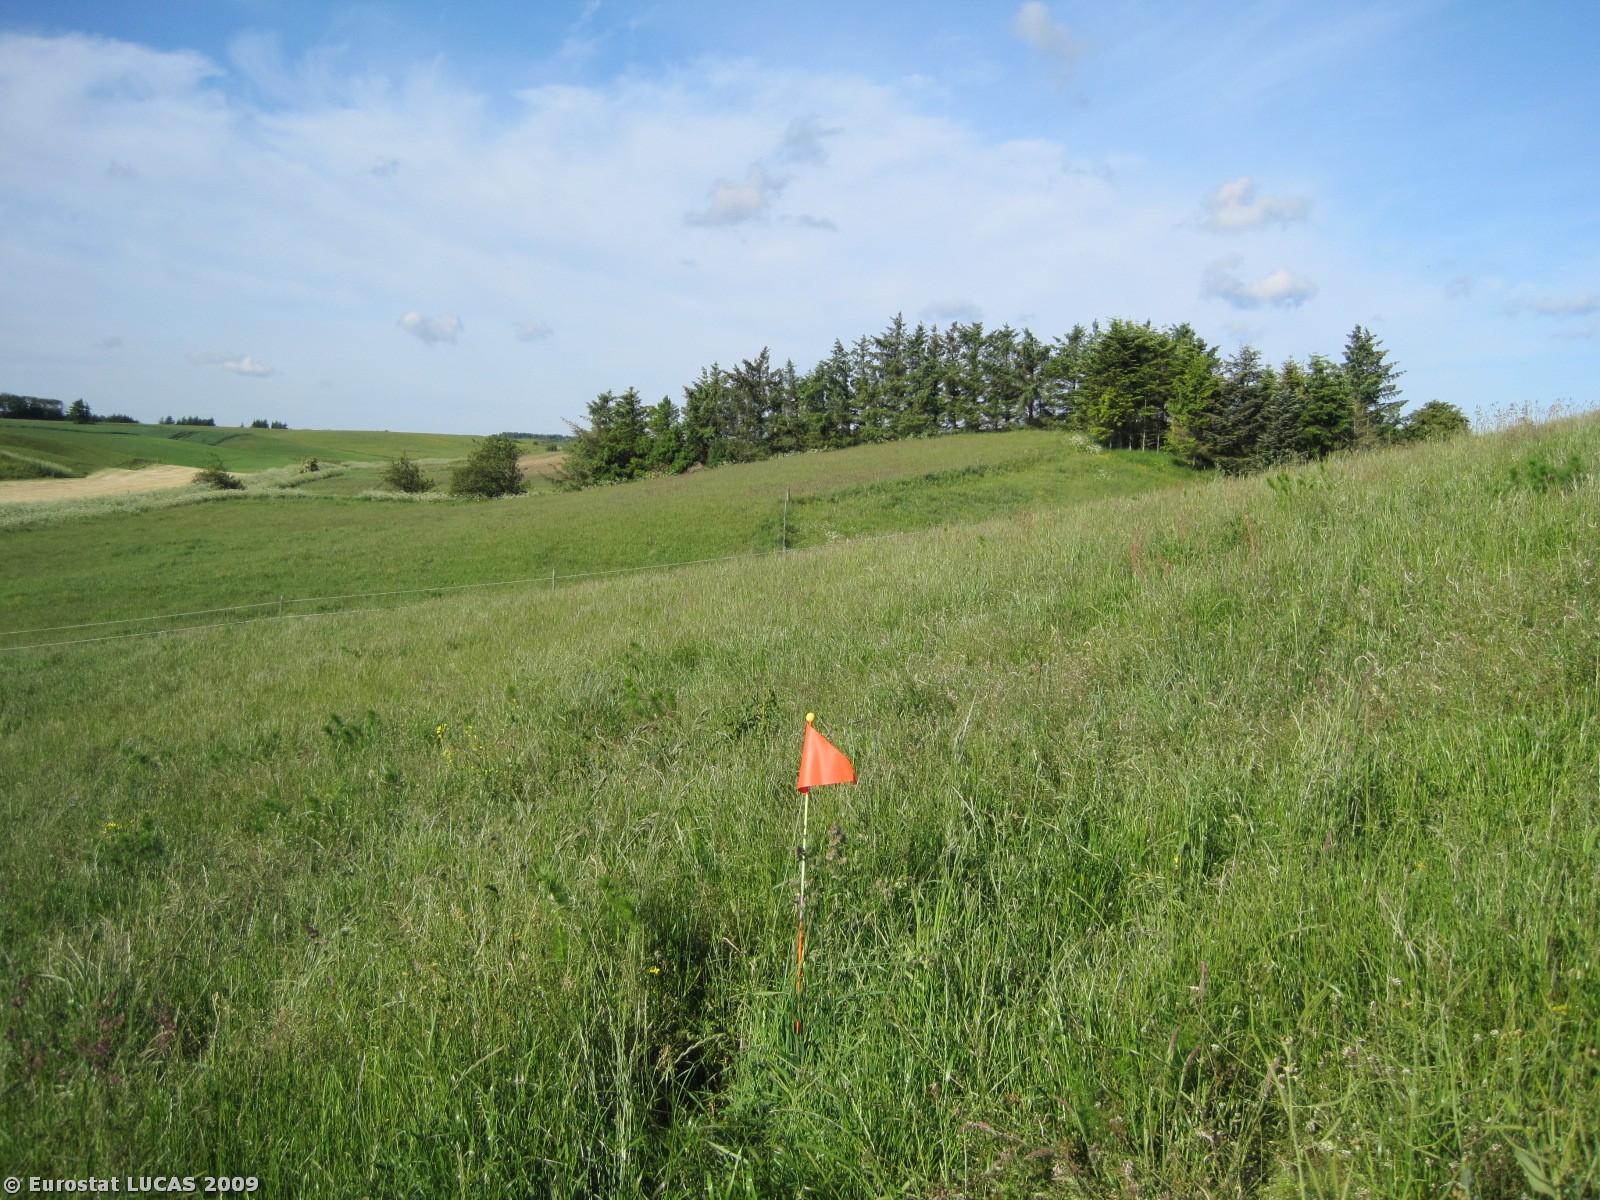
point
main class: Grassland
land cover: Grassland without tree/shrub cover
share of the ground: > 75 %
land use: Agriculture (excluding fallow land and kitchen gardens)
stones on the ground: < 10 %
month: June
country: DK
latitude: 57.4461
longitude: 9.8836
